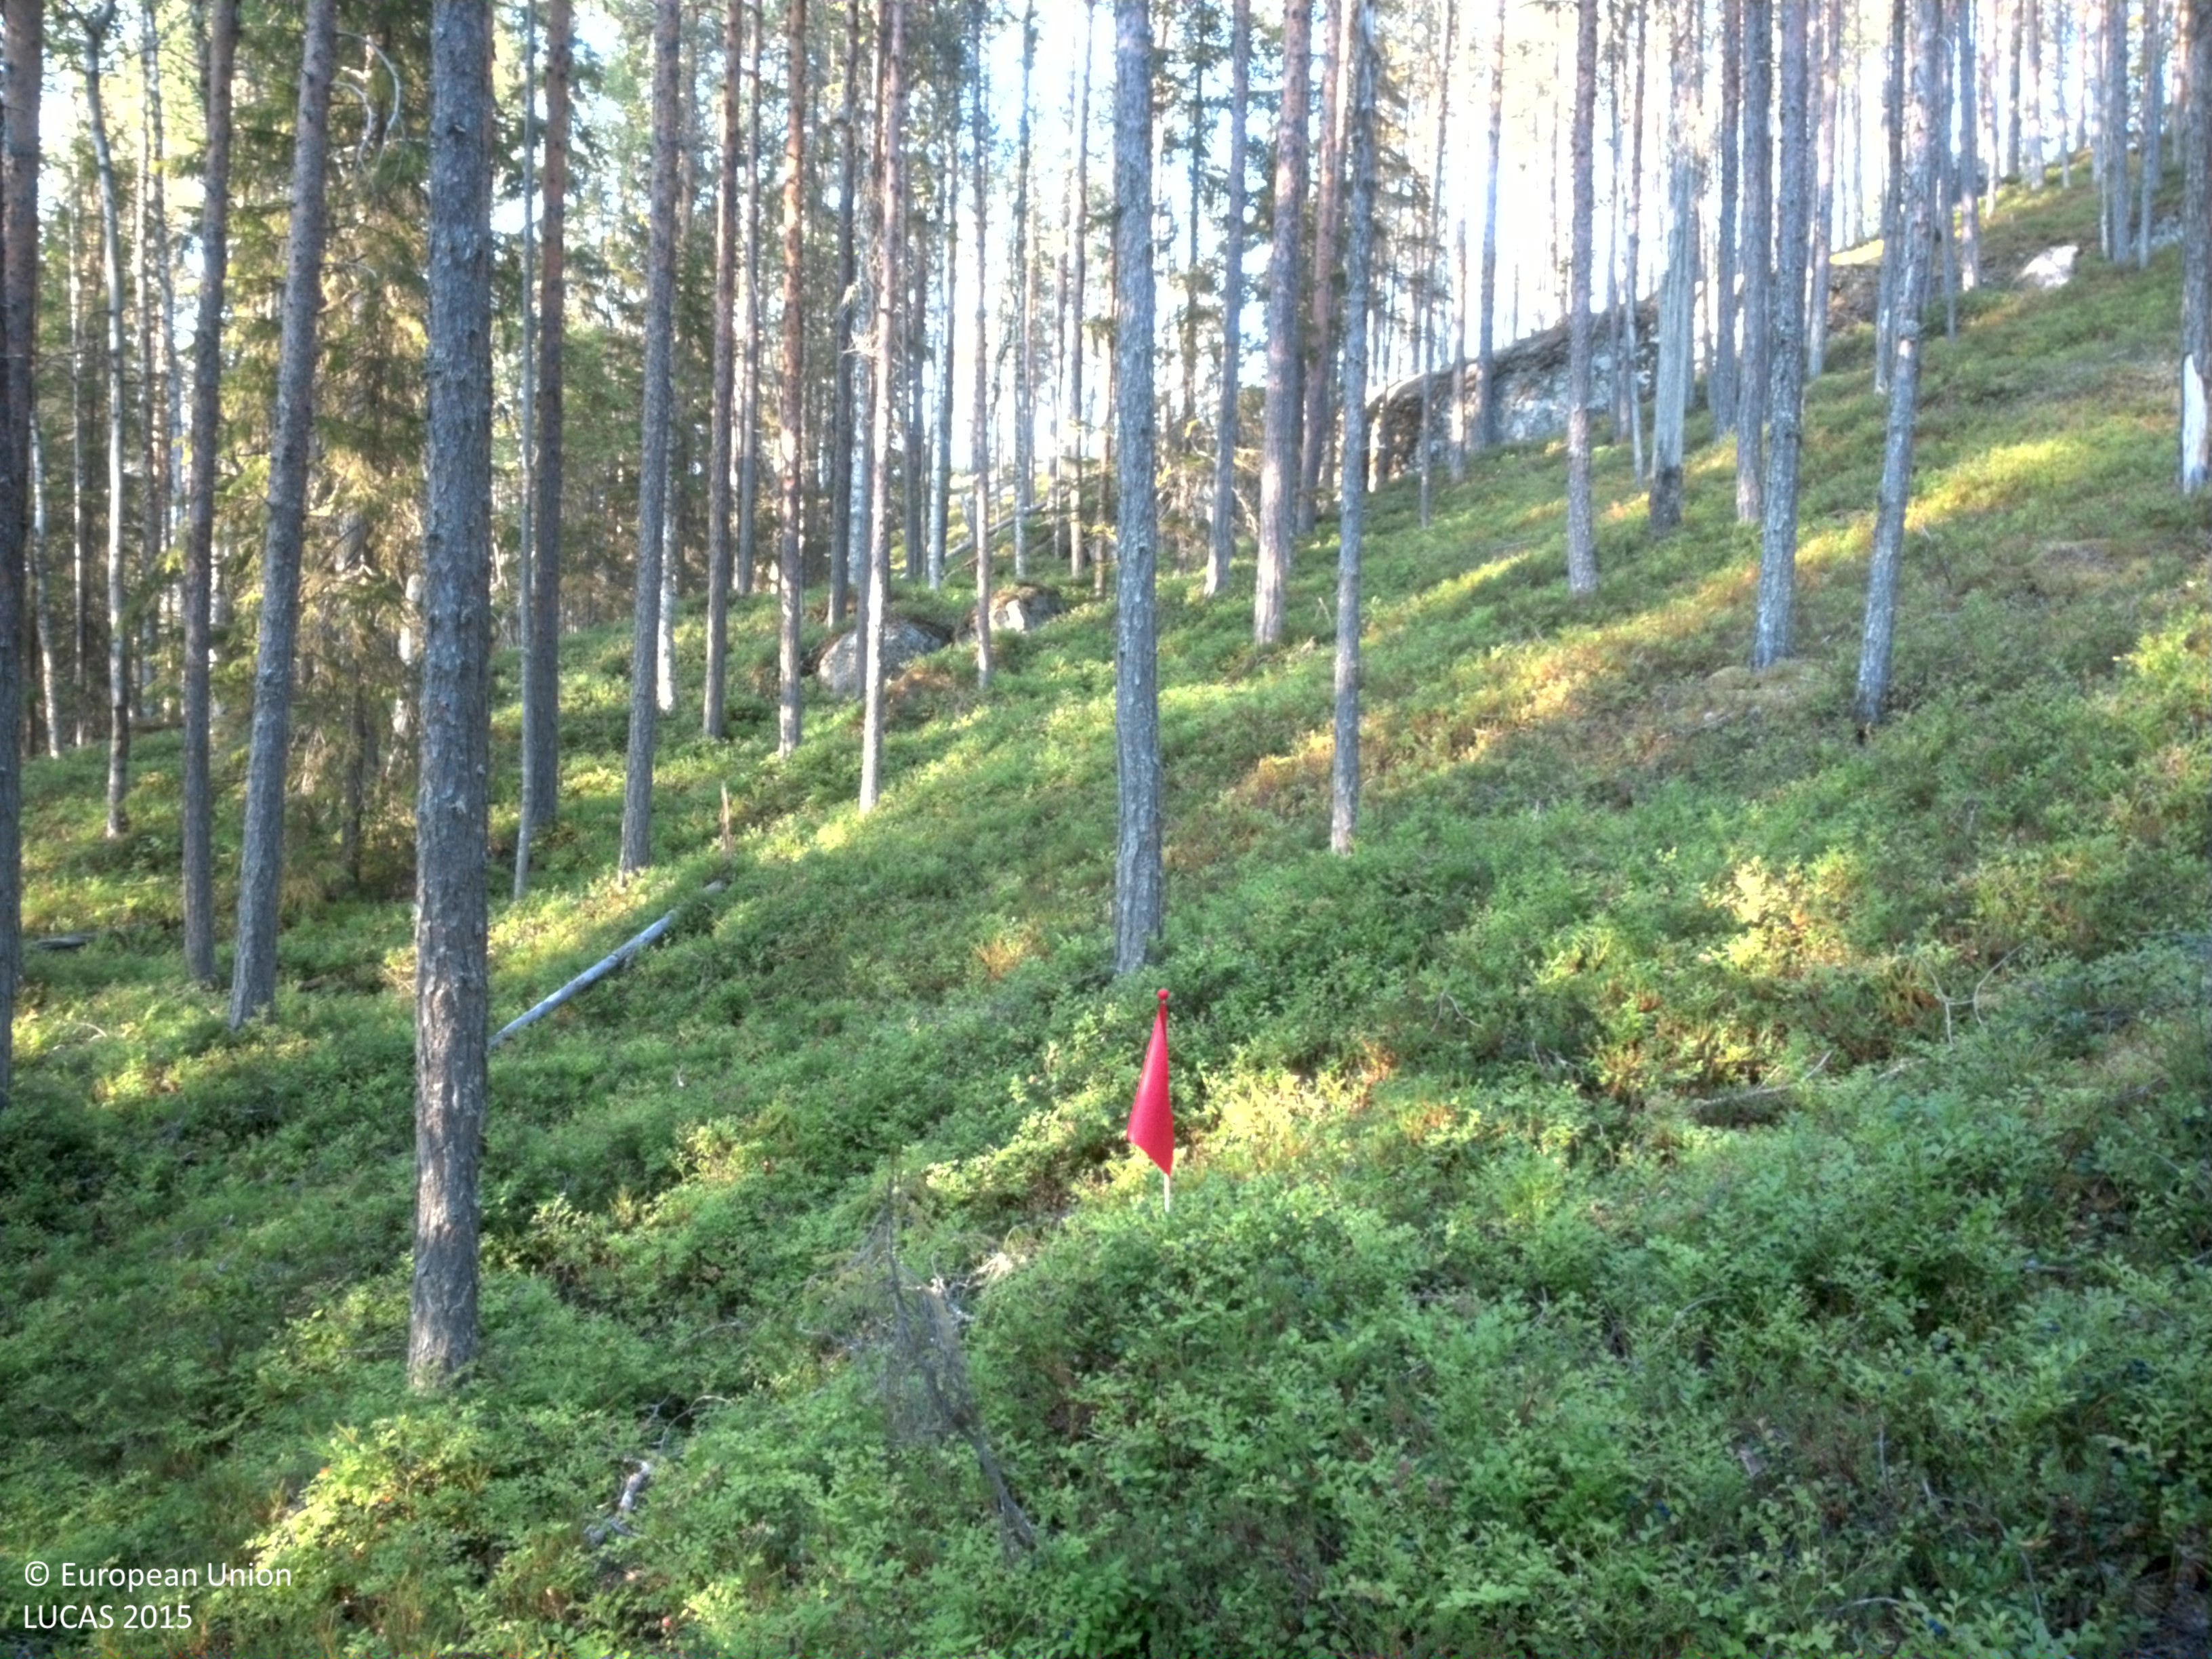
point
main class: Woodland
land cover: Pine dominated coniferous woodland
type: boreal forest
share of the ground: 25 - 50 %
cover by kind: coniferous forest trees 50 %, shrubs 50 %
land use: Forestry
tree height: > 5 m
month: August
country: SE
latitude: 64.4666
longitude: 19.0568
